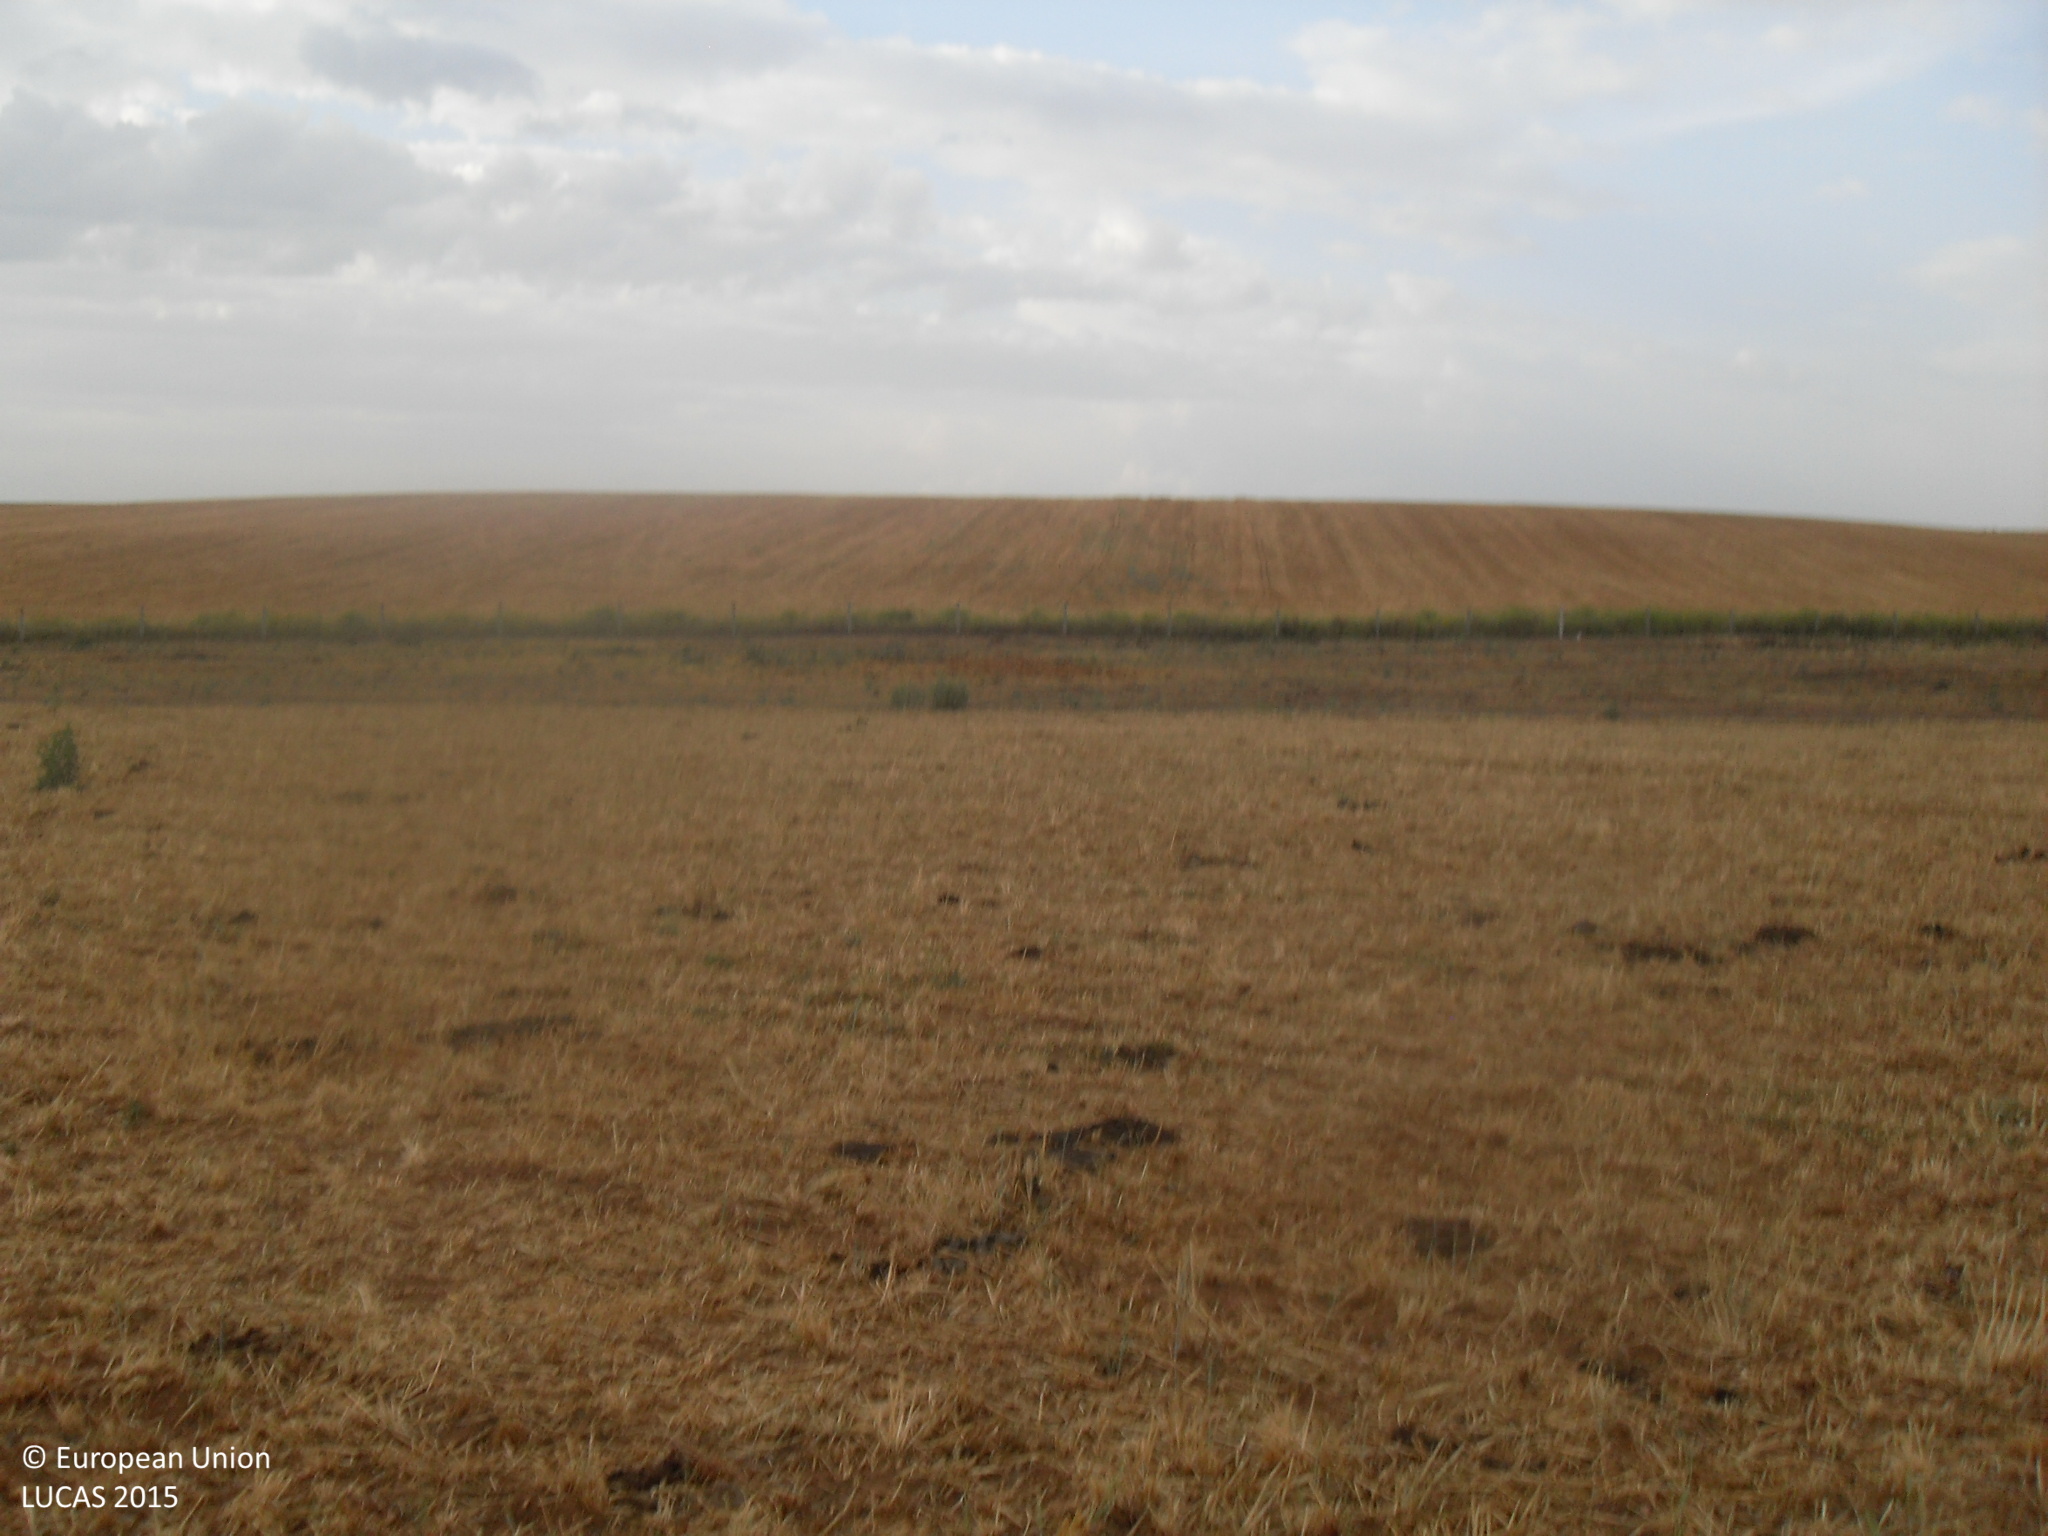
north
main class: Cropland
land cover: Rye
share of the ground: 10 - 25 %
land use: Agriculture (excluding fallow land and kitchen gardens)
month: June
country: ES
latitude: 41.0494
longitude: -5.7247
